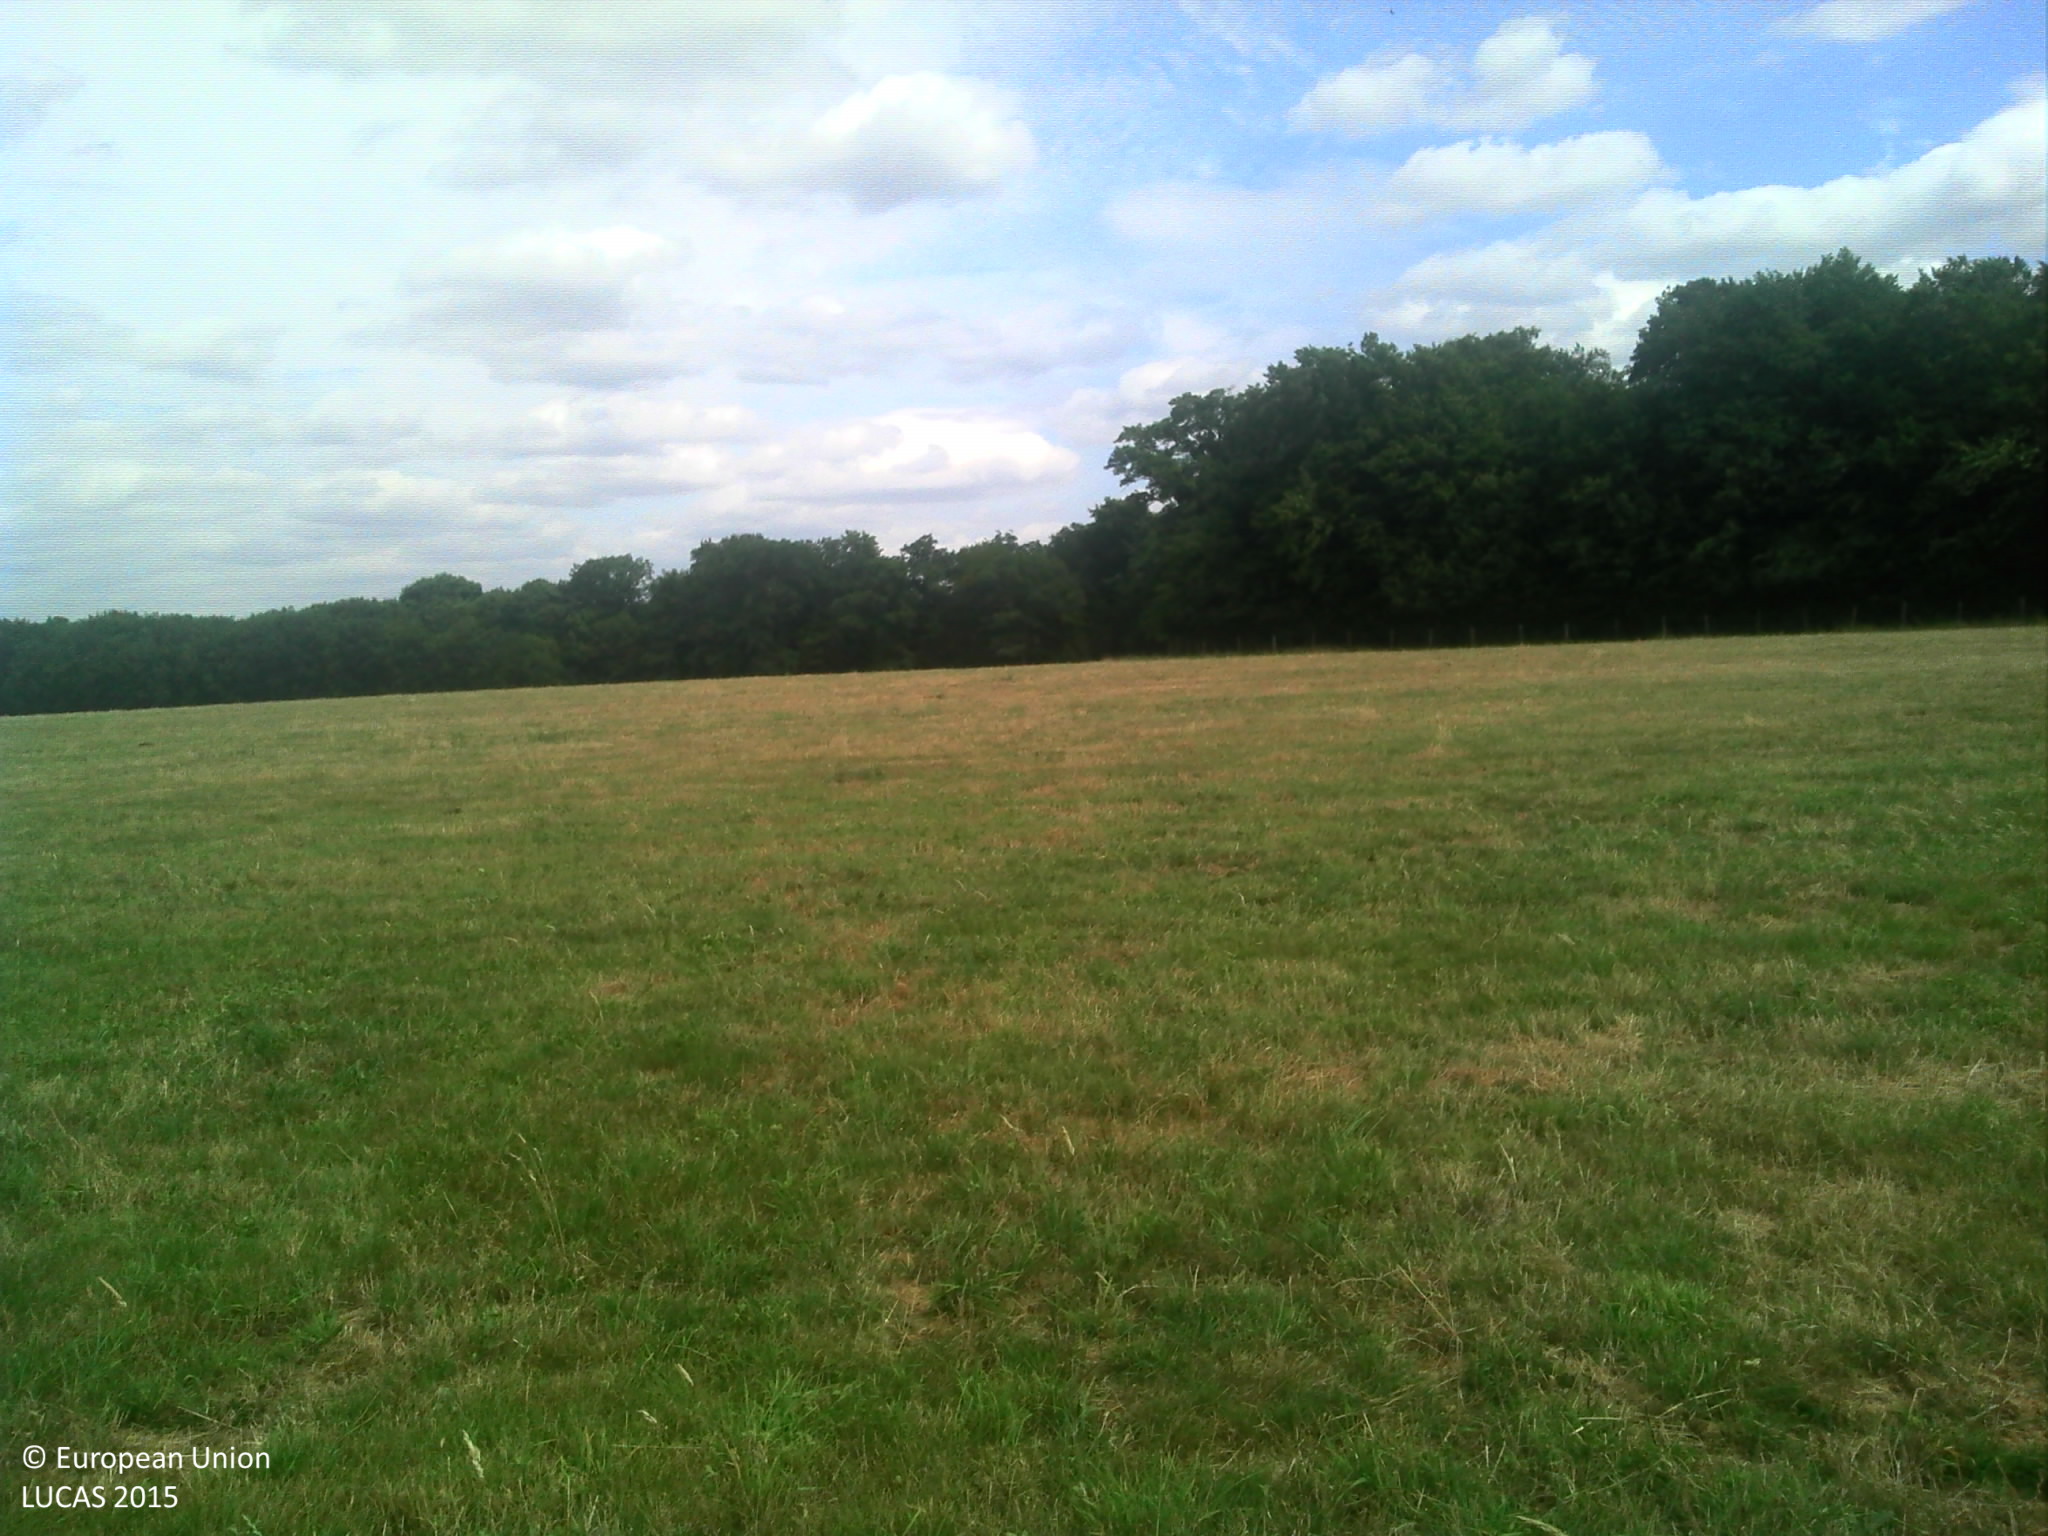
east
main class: Grassland
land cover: Grassland without tree/shrub cover
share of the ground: > 75 %
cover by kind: herbaceous plants 100 %
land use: Agriculture (excluding fallow land and kitchen gardens)
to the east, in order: Grassland without tree/shrub cover
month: July
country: FR
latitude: 48.0965
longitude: 5.0981
